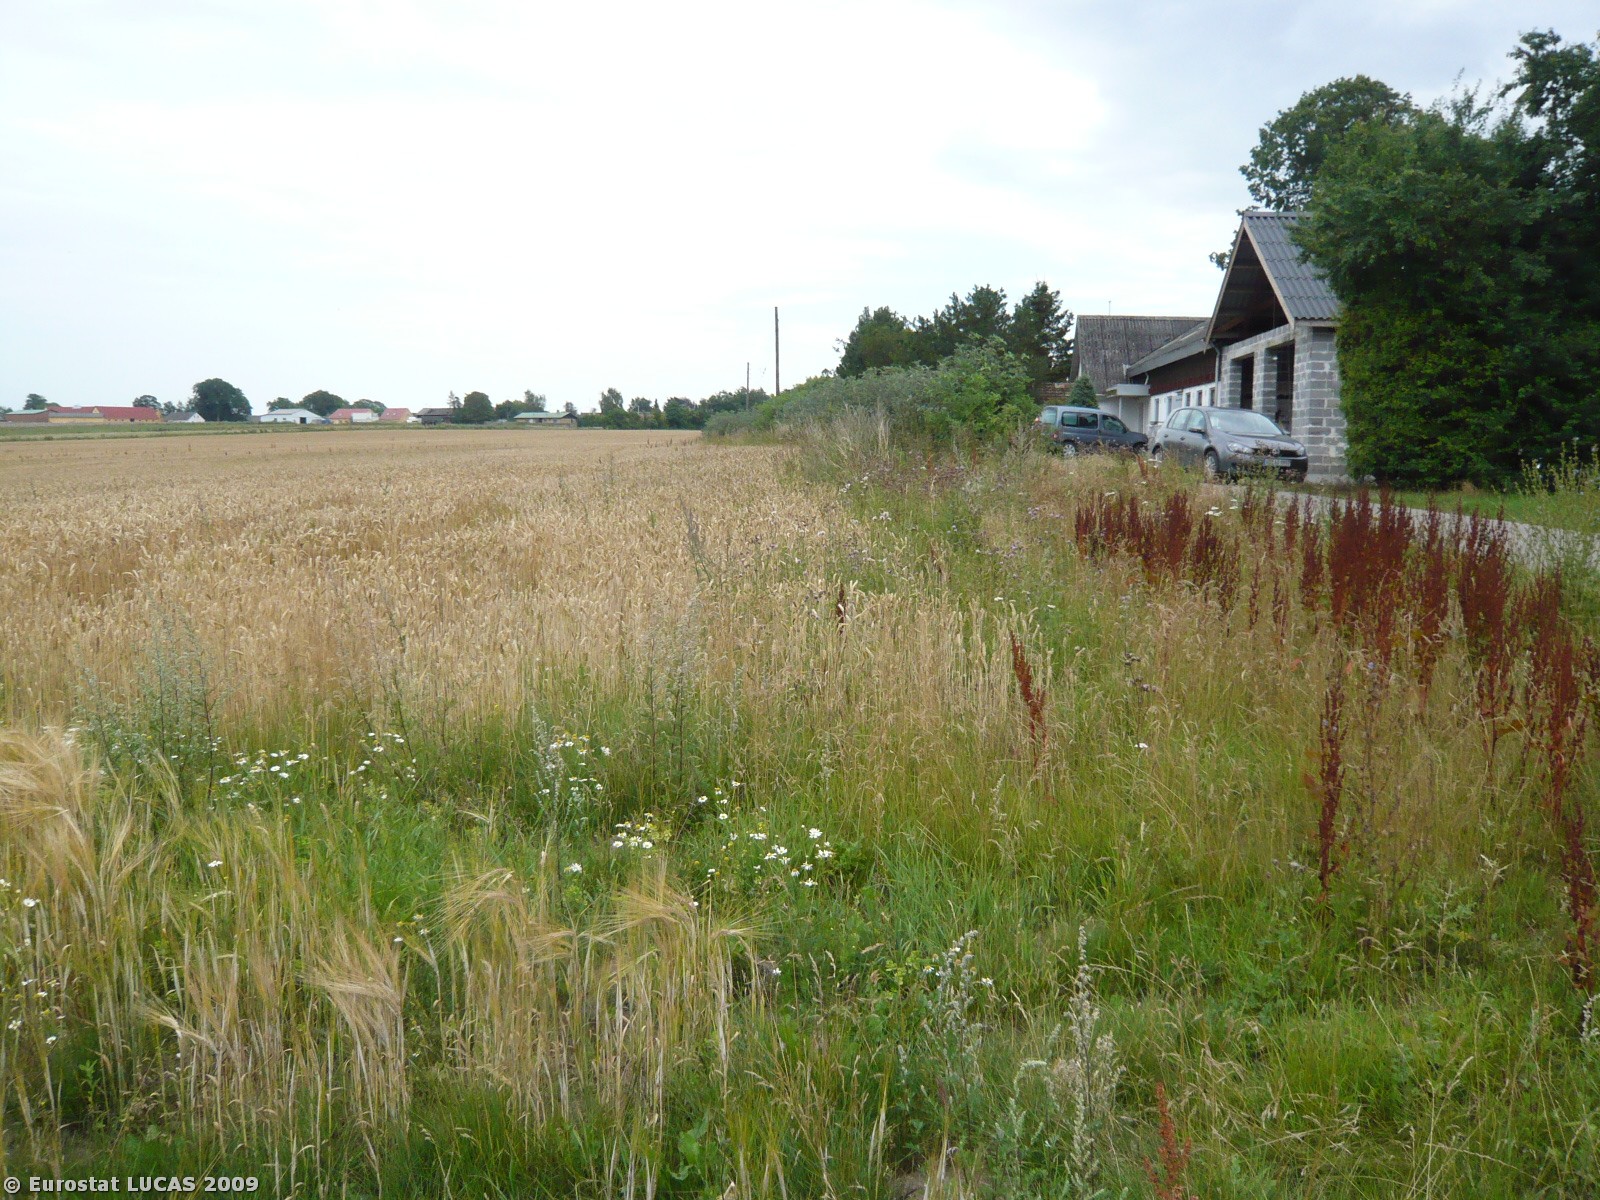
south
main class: Cropland
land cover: Barley
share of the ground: > 75 %
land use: Agriculture (excluding fallow land and kitchen gardens)
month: July
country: DK
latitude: 55.8830
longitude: 12.0923
